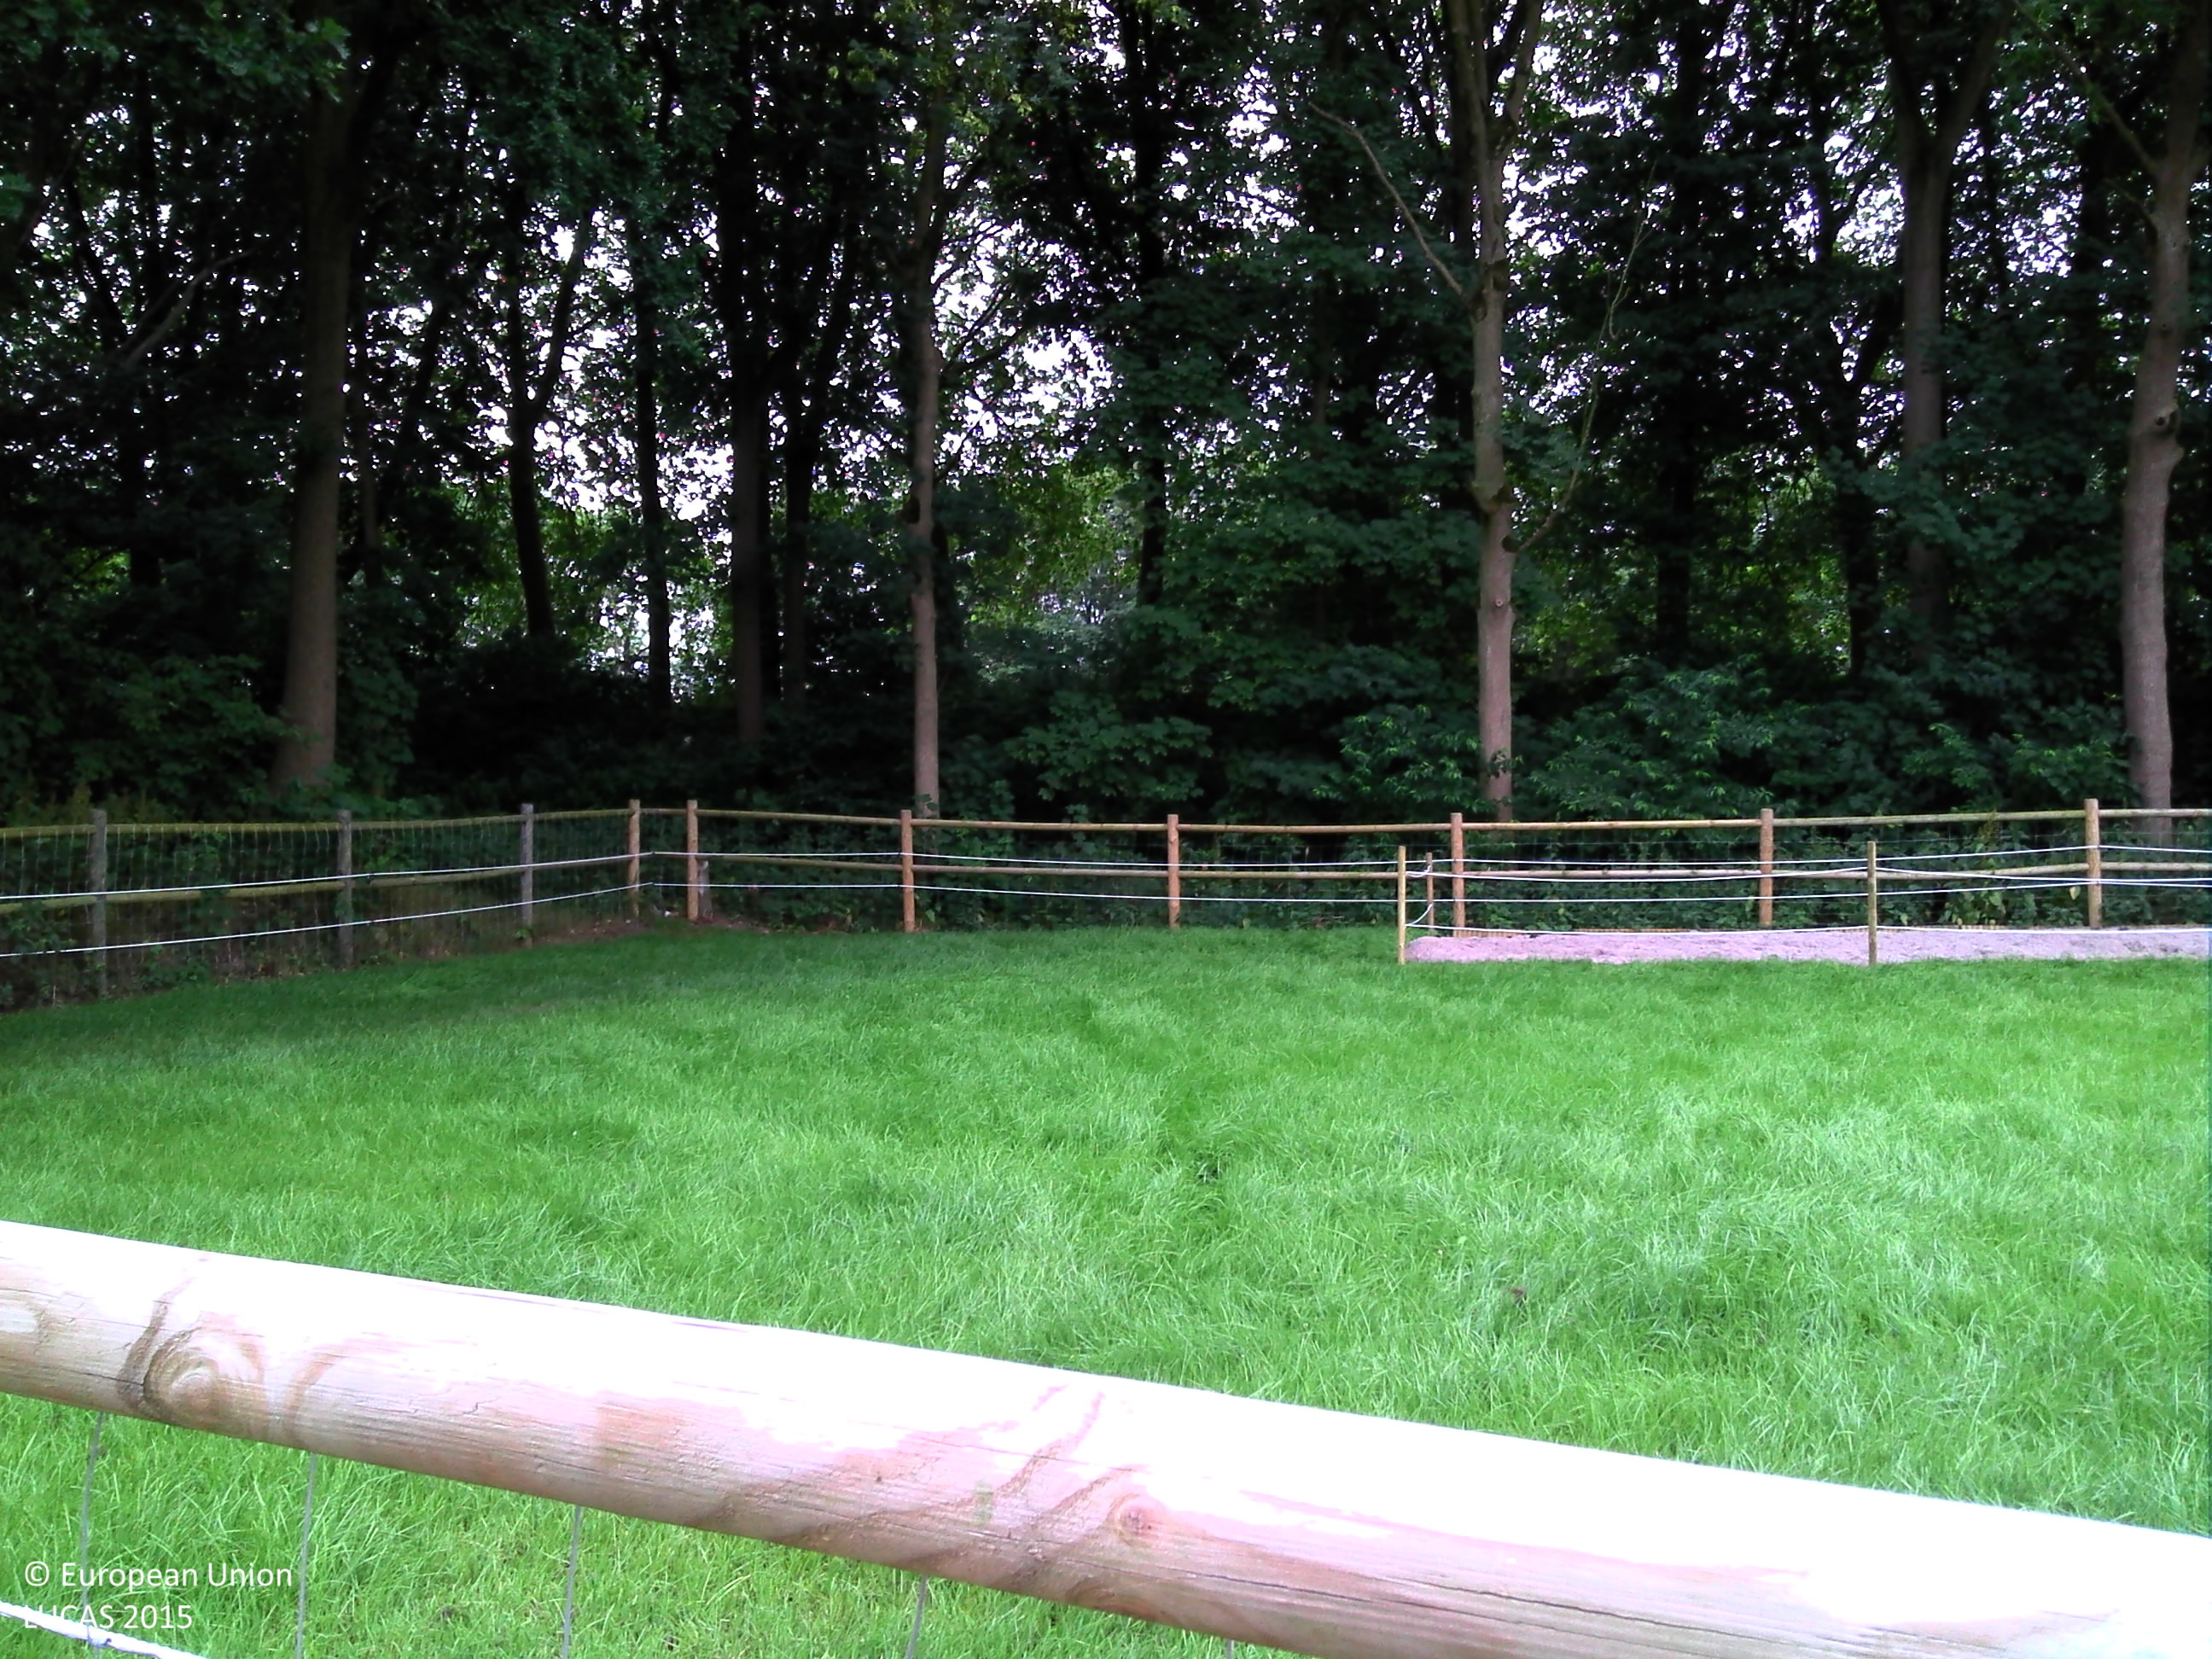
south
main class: Woodland
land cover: Broadleaved woodland
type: mesophytic deciduous forest
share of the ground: > 75 %
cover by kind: broadleaved forest trees 90 %, herbaceous plants 10 %
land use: Semi-natural and natural areas not in use
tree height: > 5 m
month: July
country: BE
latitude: 51.2295
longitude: 5.4871
